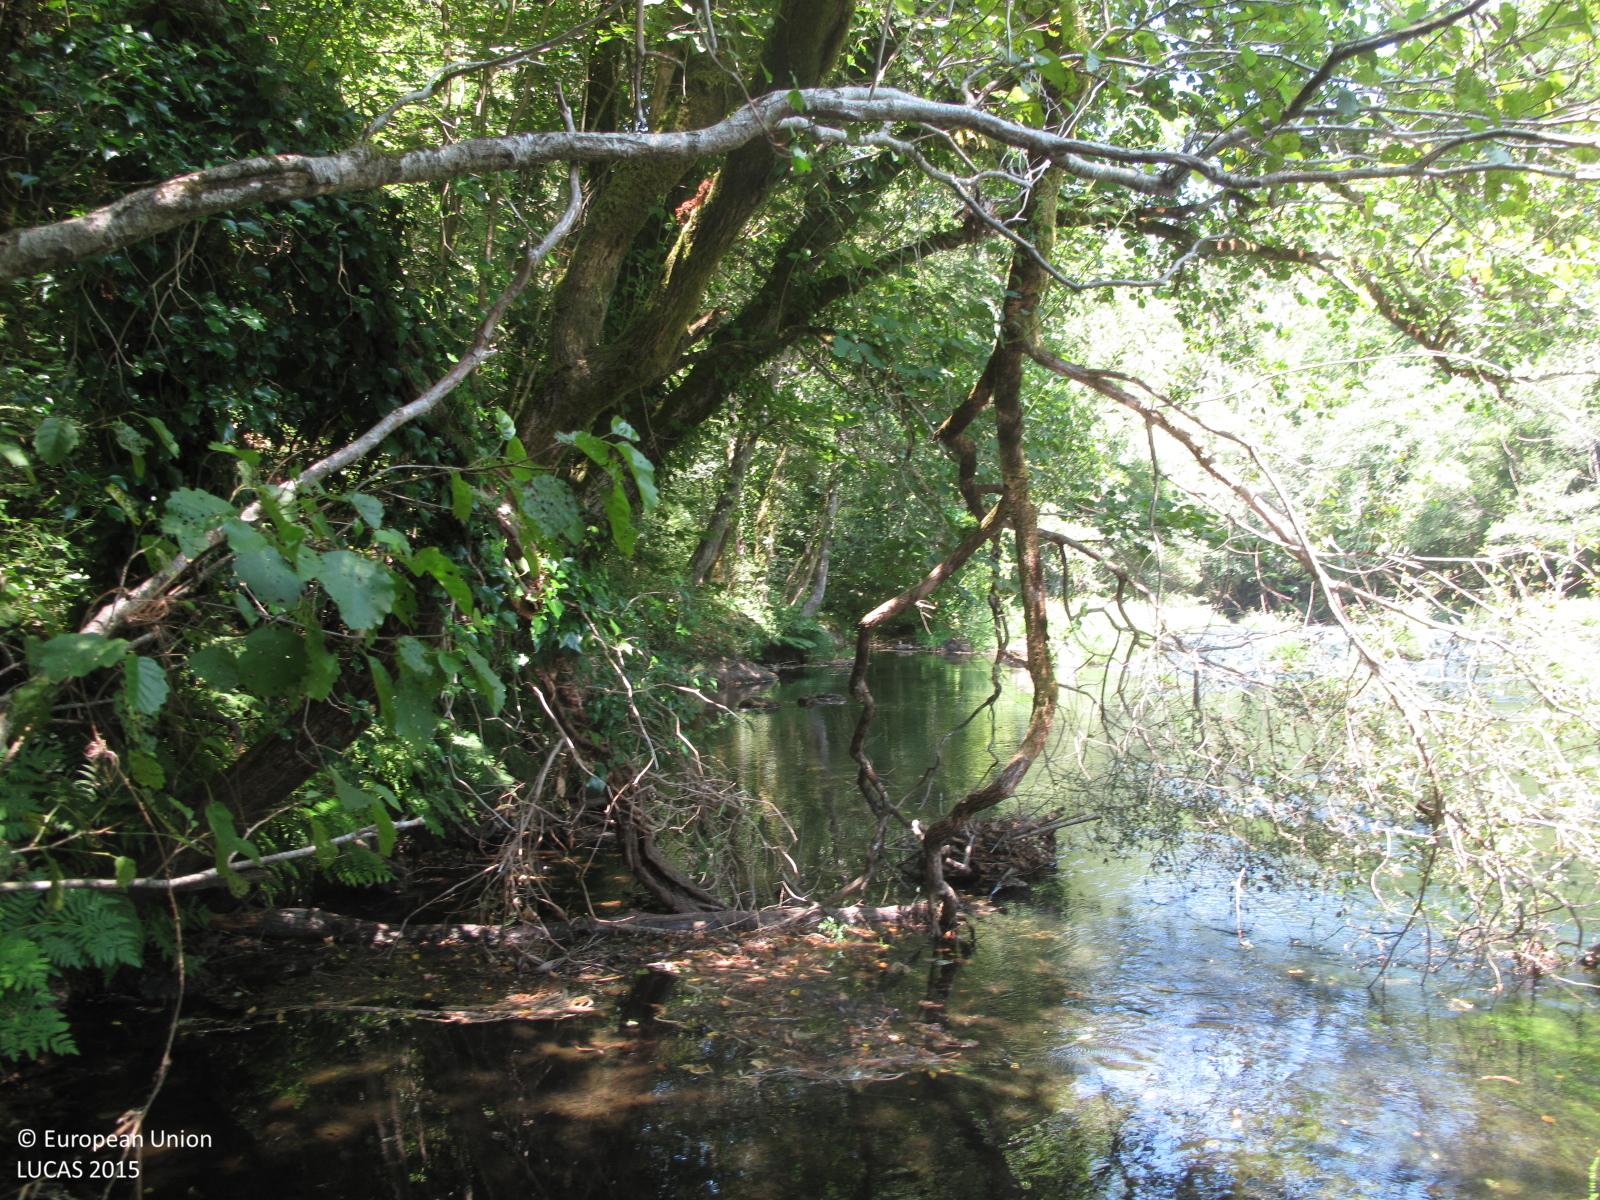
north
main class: Woodland
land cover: Broadleaved woodland
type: acidophilous oak and oak-birch forest
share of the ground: > 75 %
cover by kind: broadleaved forest trees 100 %
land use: Semi-natural and natural areas not in use
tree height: > 5 m
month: July
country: ES
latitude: 43.4085
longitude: -8.0899
